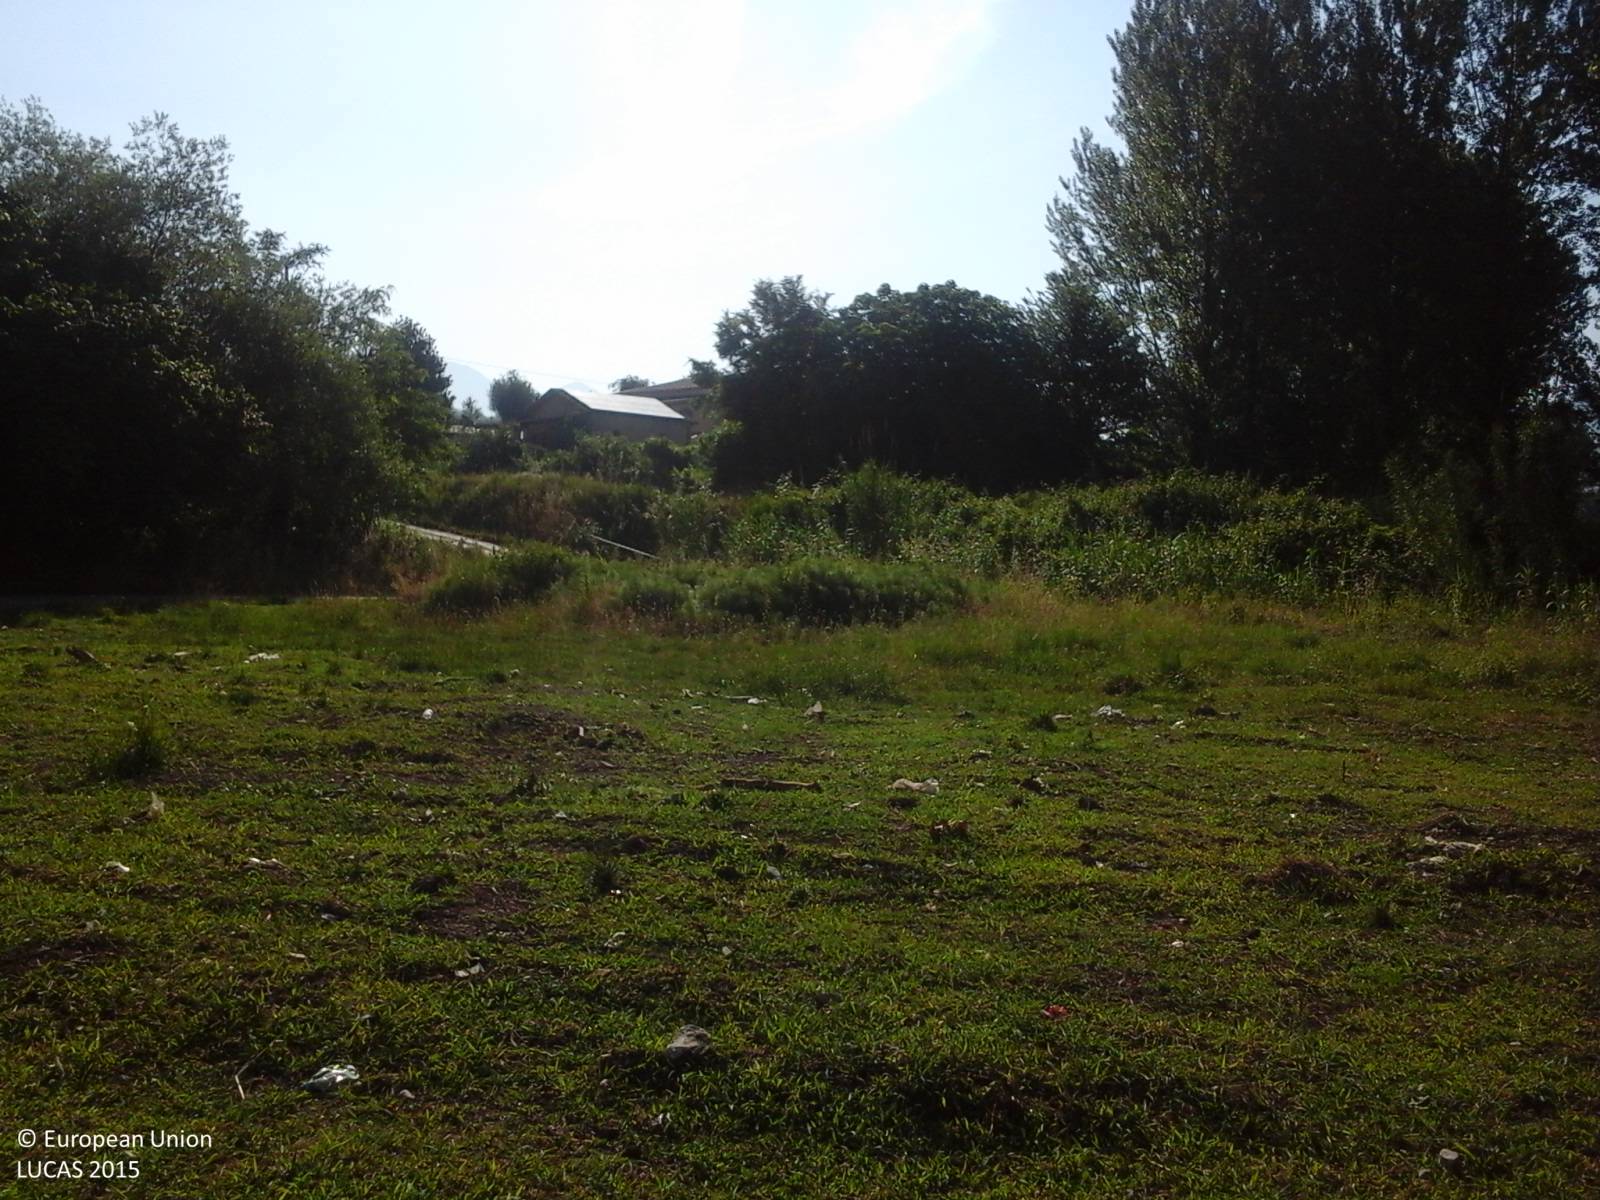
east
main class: Grassland
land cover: Spontaneously vegetated surfaces
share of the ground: > 75 %
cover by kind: herbaceous plants 100 %
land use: Agriculture (excluding fallow land and kitchen gardens)
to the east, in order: Ditches and canals; Spontaneously vegetated surfaces; Paved roads, cycling and walking lanes; Inland fresh running water; Paved roads, cycling and walking lanes; Grass margins; Managed hedges; Spontaneously vegetated surfaces; Artificial constructions in urban areas; Managed hedges; Spontaneously vegetated surfaces; Single bushes/trees; Spontaneously vegetated surfaces; Other fruit trees and berries; Spontaneously vegetated surfaces
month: June
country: IT
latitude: 41.0905
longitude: 14.4468
